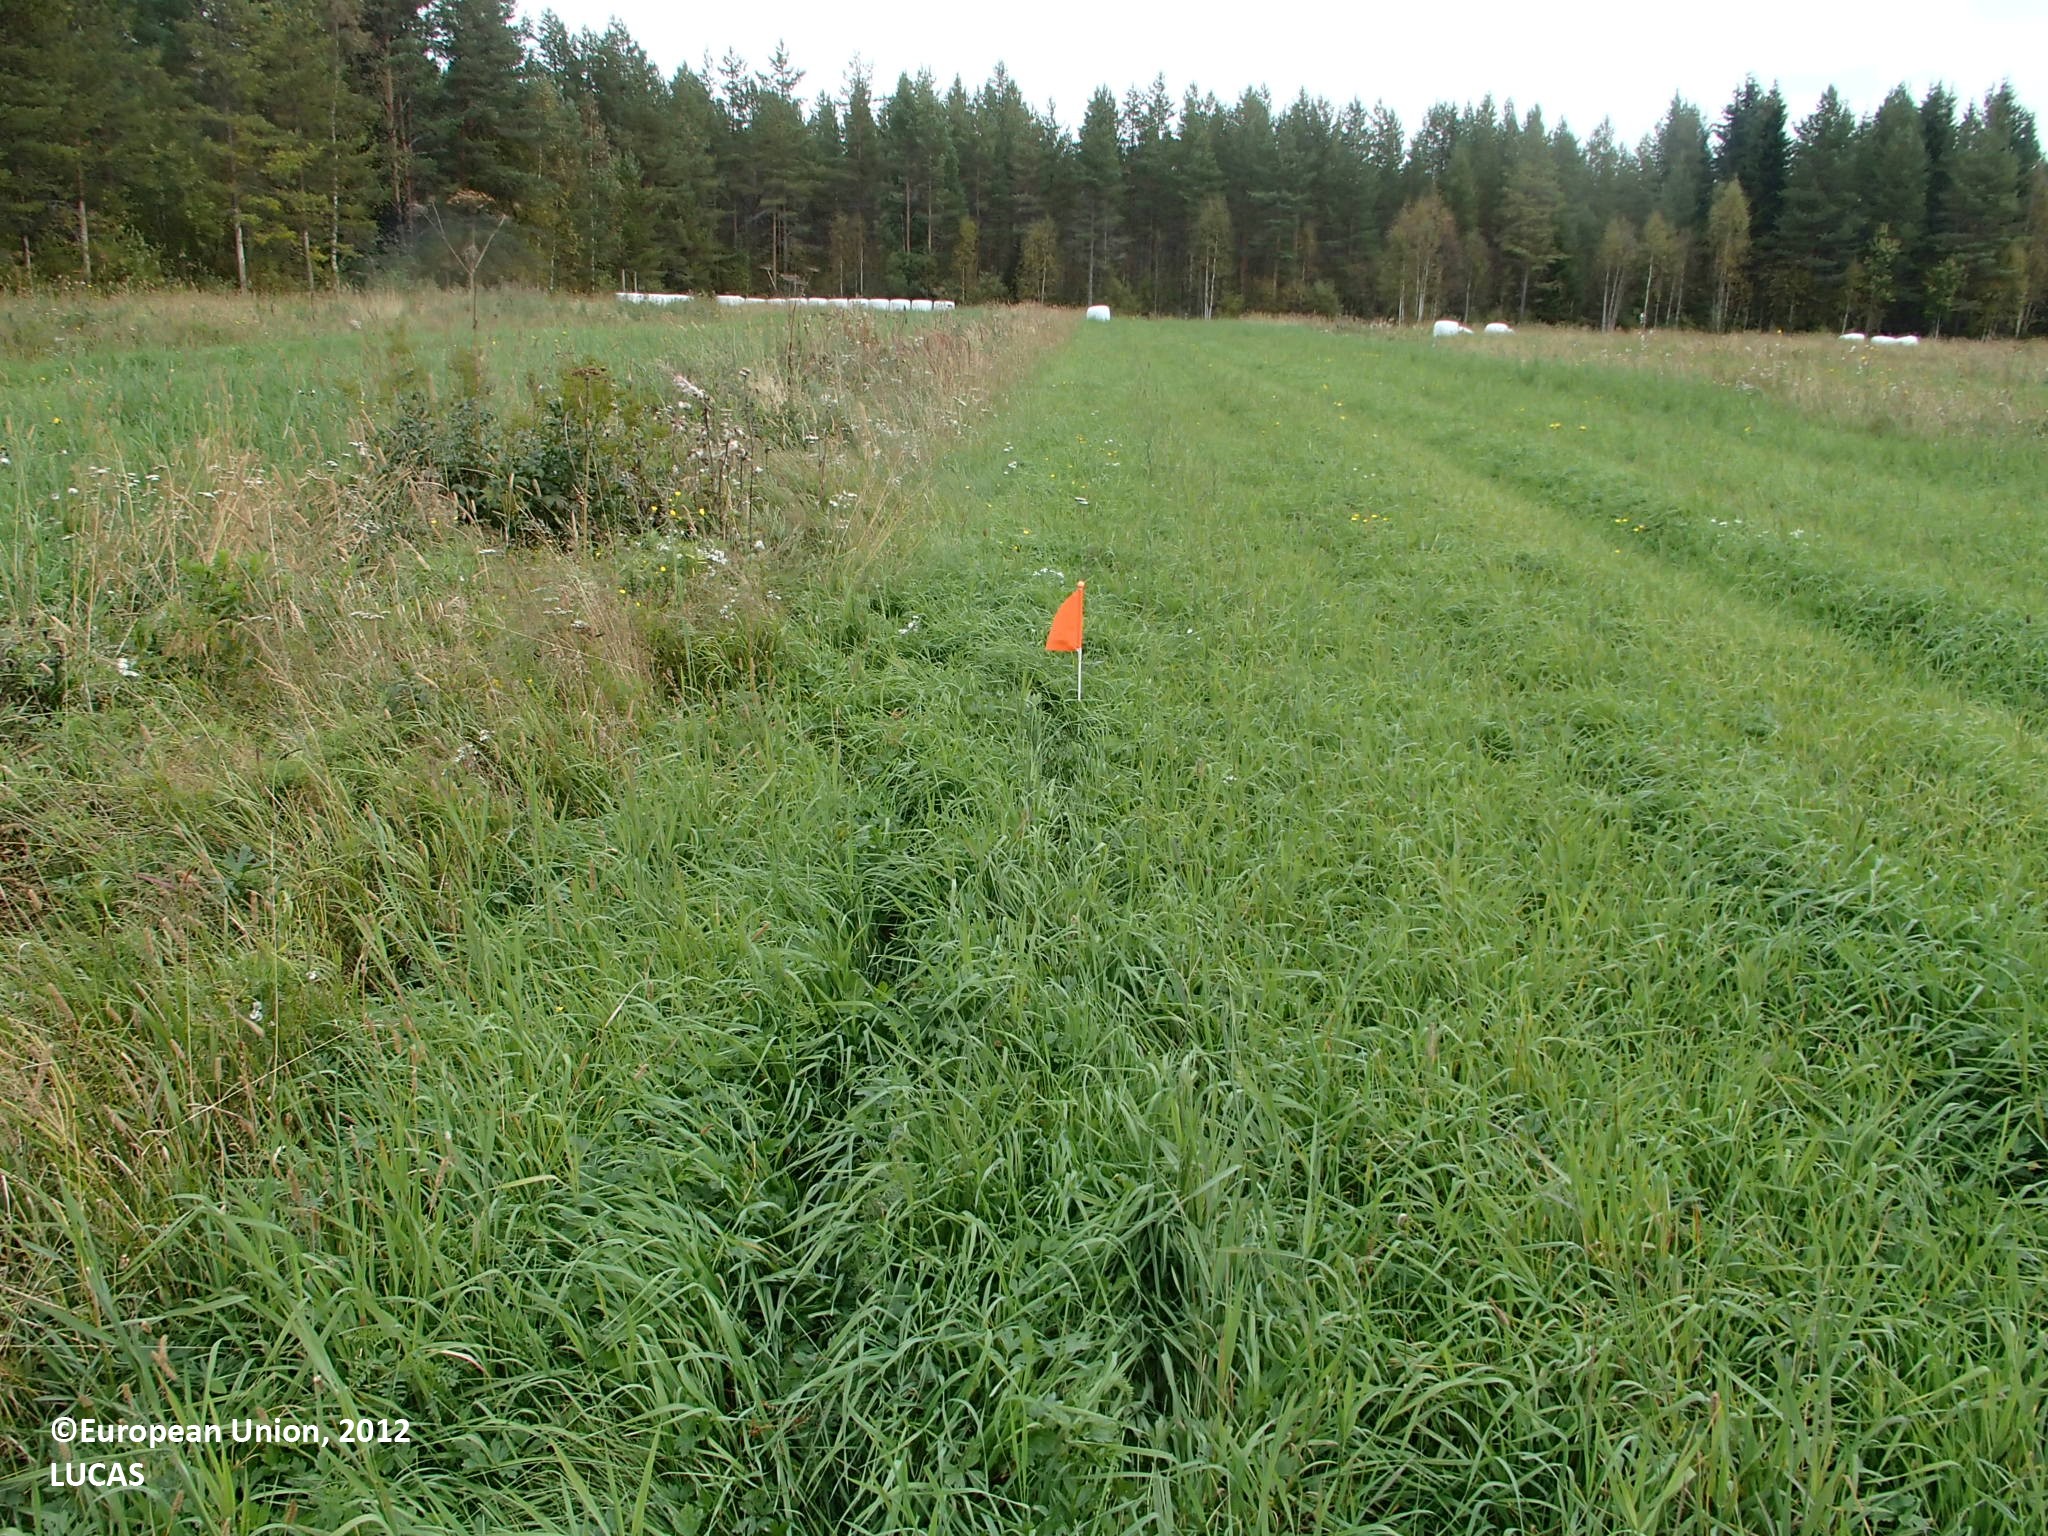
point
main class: Cropland
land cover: Temporary grasslands
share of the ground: > 75 %
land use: Agriculture (excluding fallow land and kitchen gardens)
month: September
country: FI
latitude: 63.8080
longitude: 25.9271
